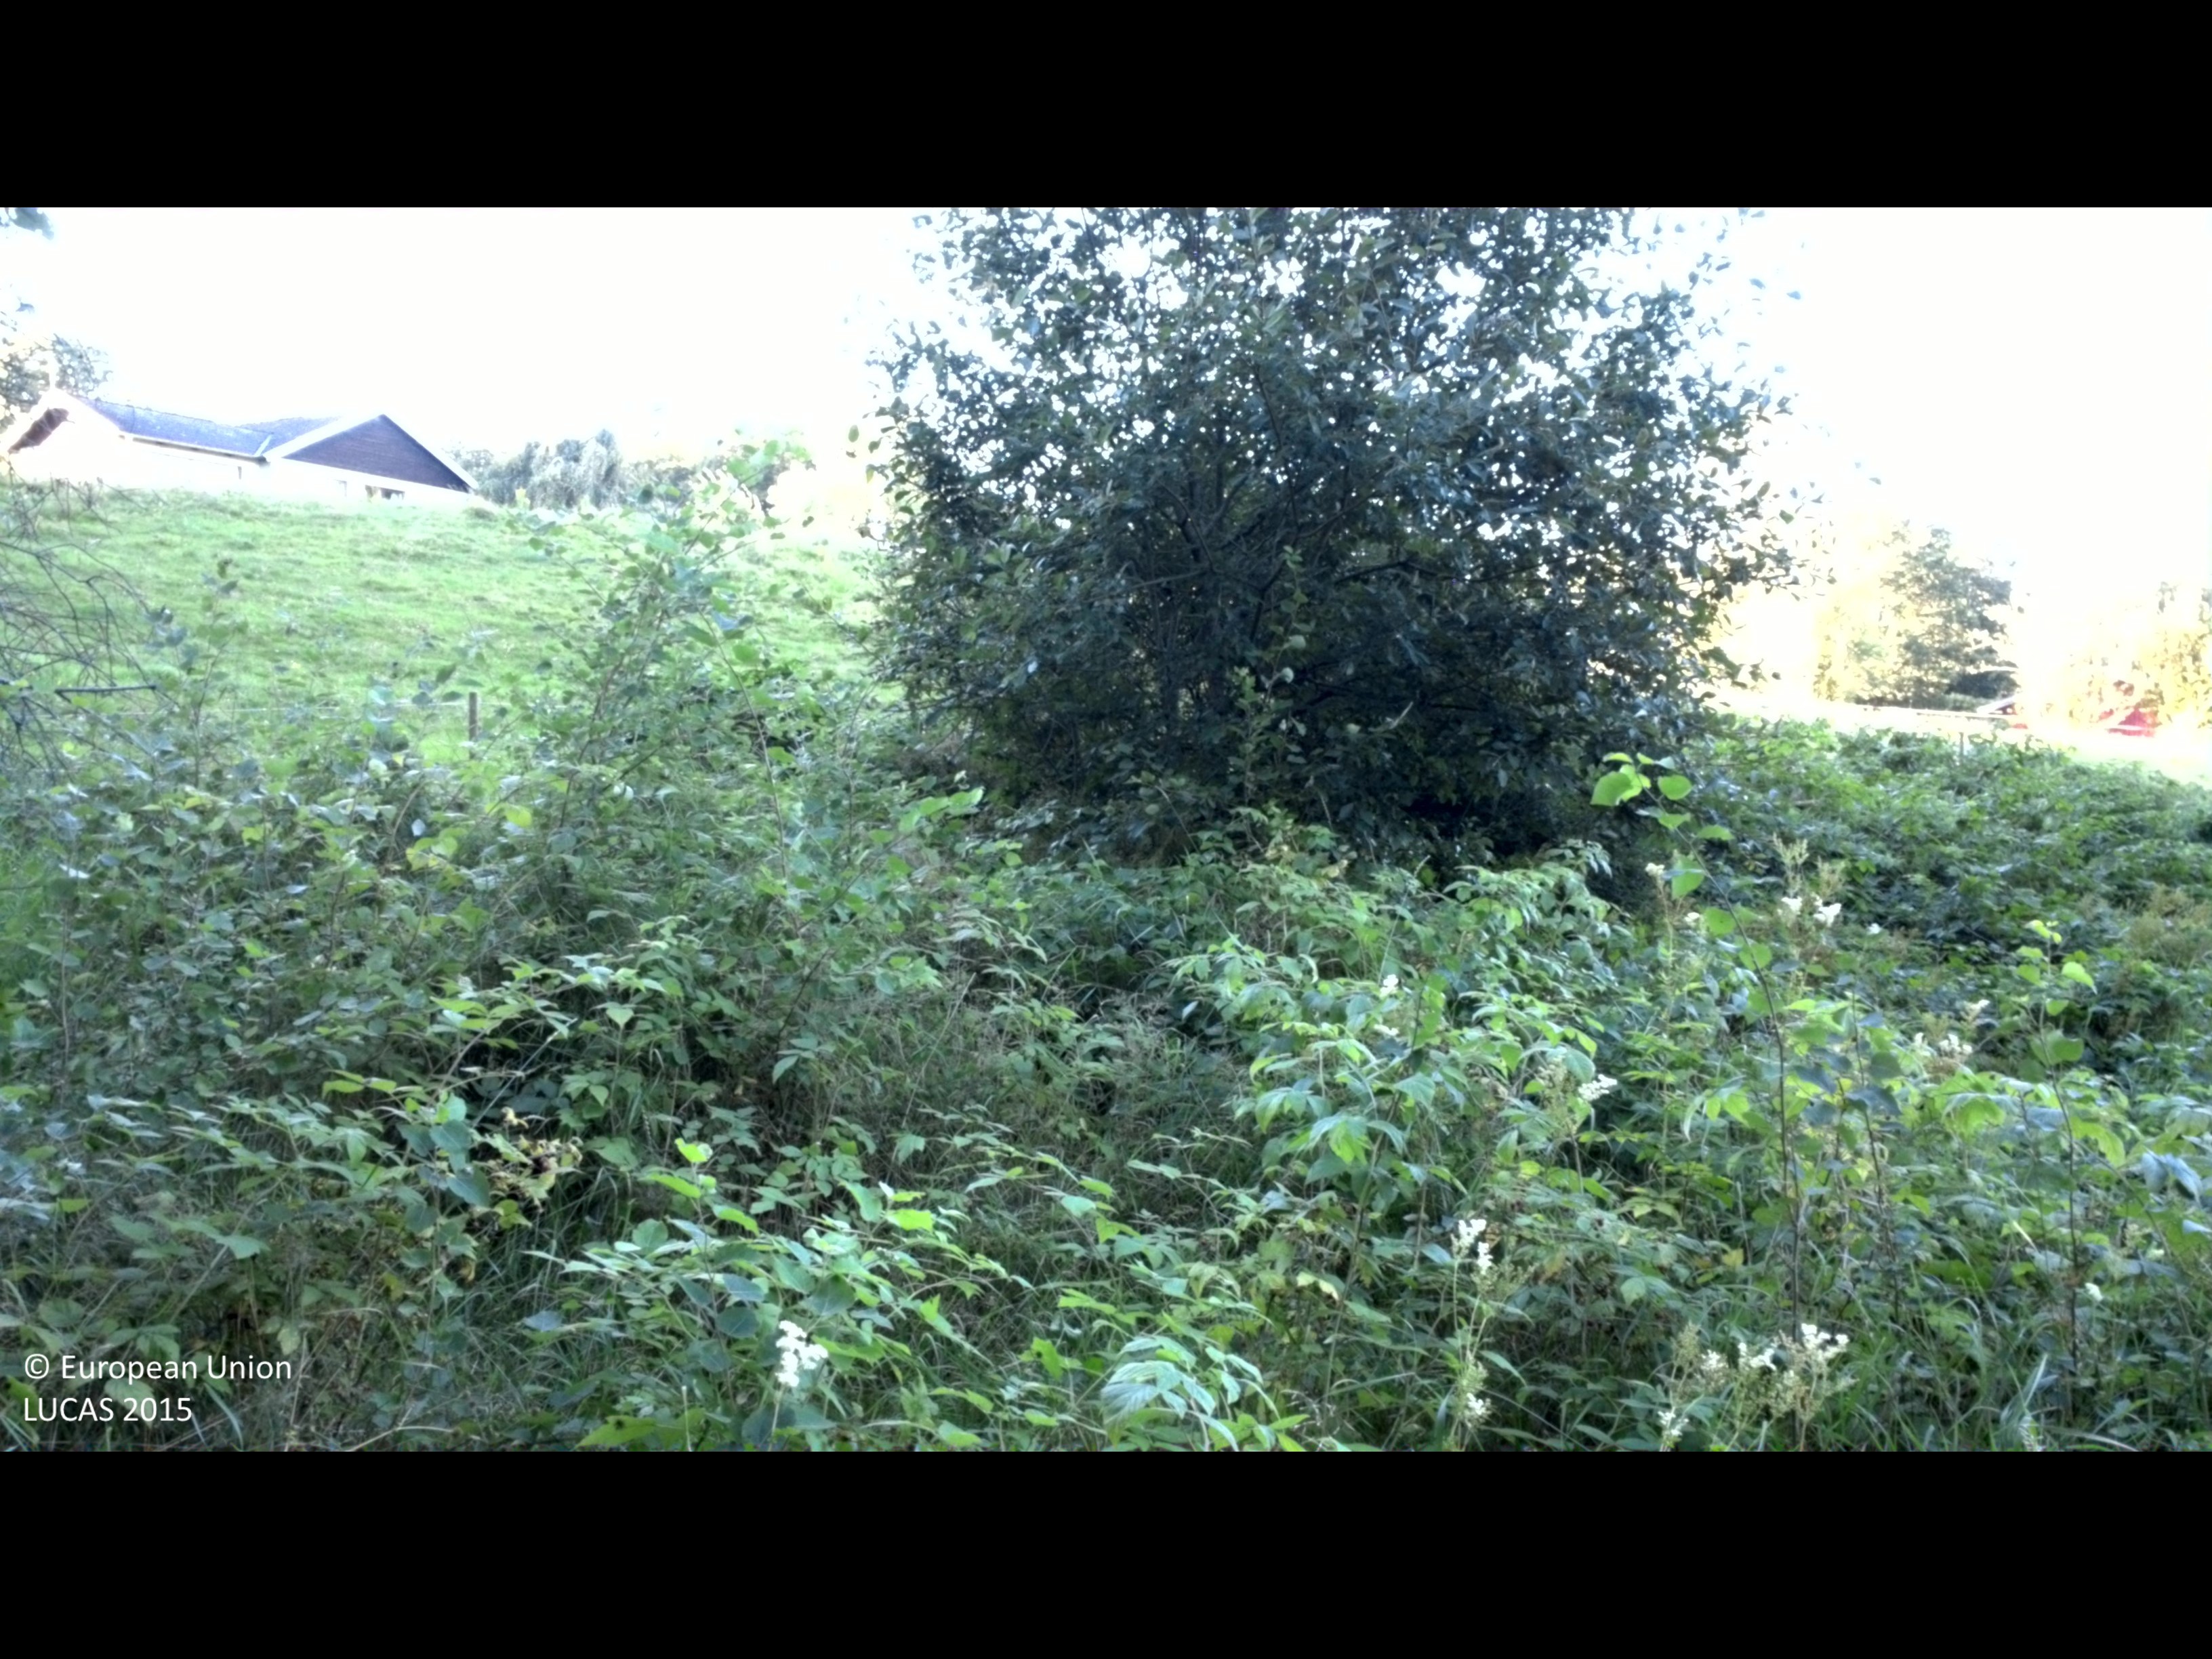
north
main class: Woodland
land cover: Broadleaved woodland
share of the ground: 50 - 75 %
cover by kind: broadleaved forest trees 60 %, shrubs 40 %
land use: Semi-natural and natural areas not in use
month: August
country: SE
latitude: 57.0106
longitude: 13.2404
